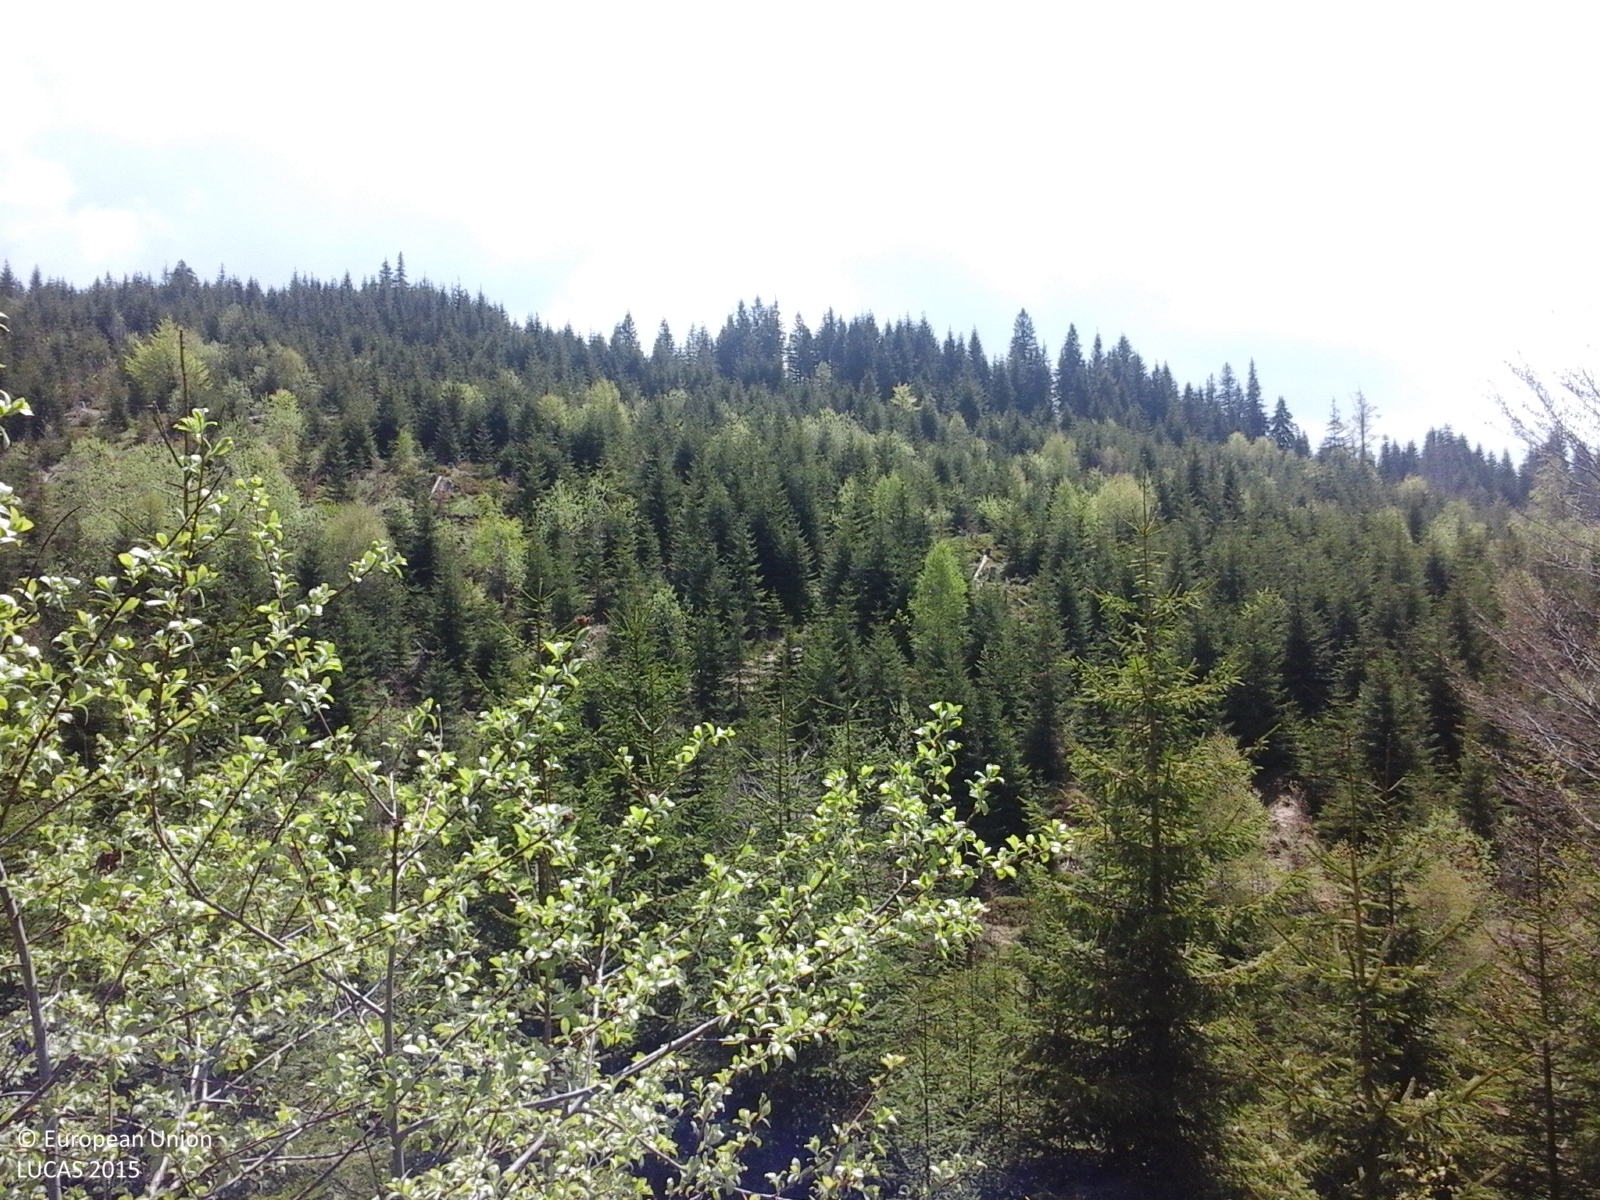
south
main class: Woodland
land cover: Spruce dominated mixed woodland
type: alpine coniferous forest
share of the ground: > 75 %
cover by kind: coniferous forest trees 75 %, broadleaved forest trees 25 %
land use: Forestry
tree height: > 5 m
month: May
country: RO
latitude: 45.8631
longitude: 26.2885
